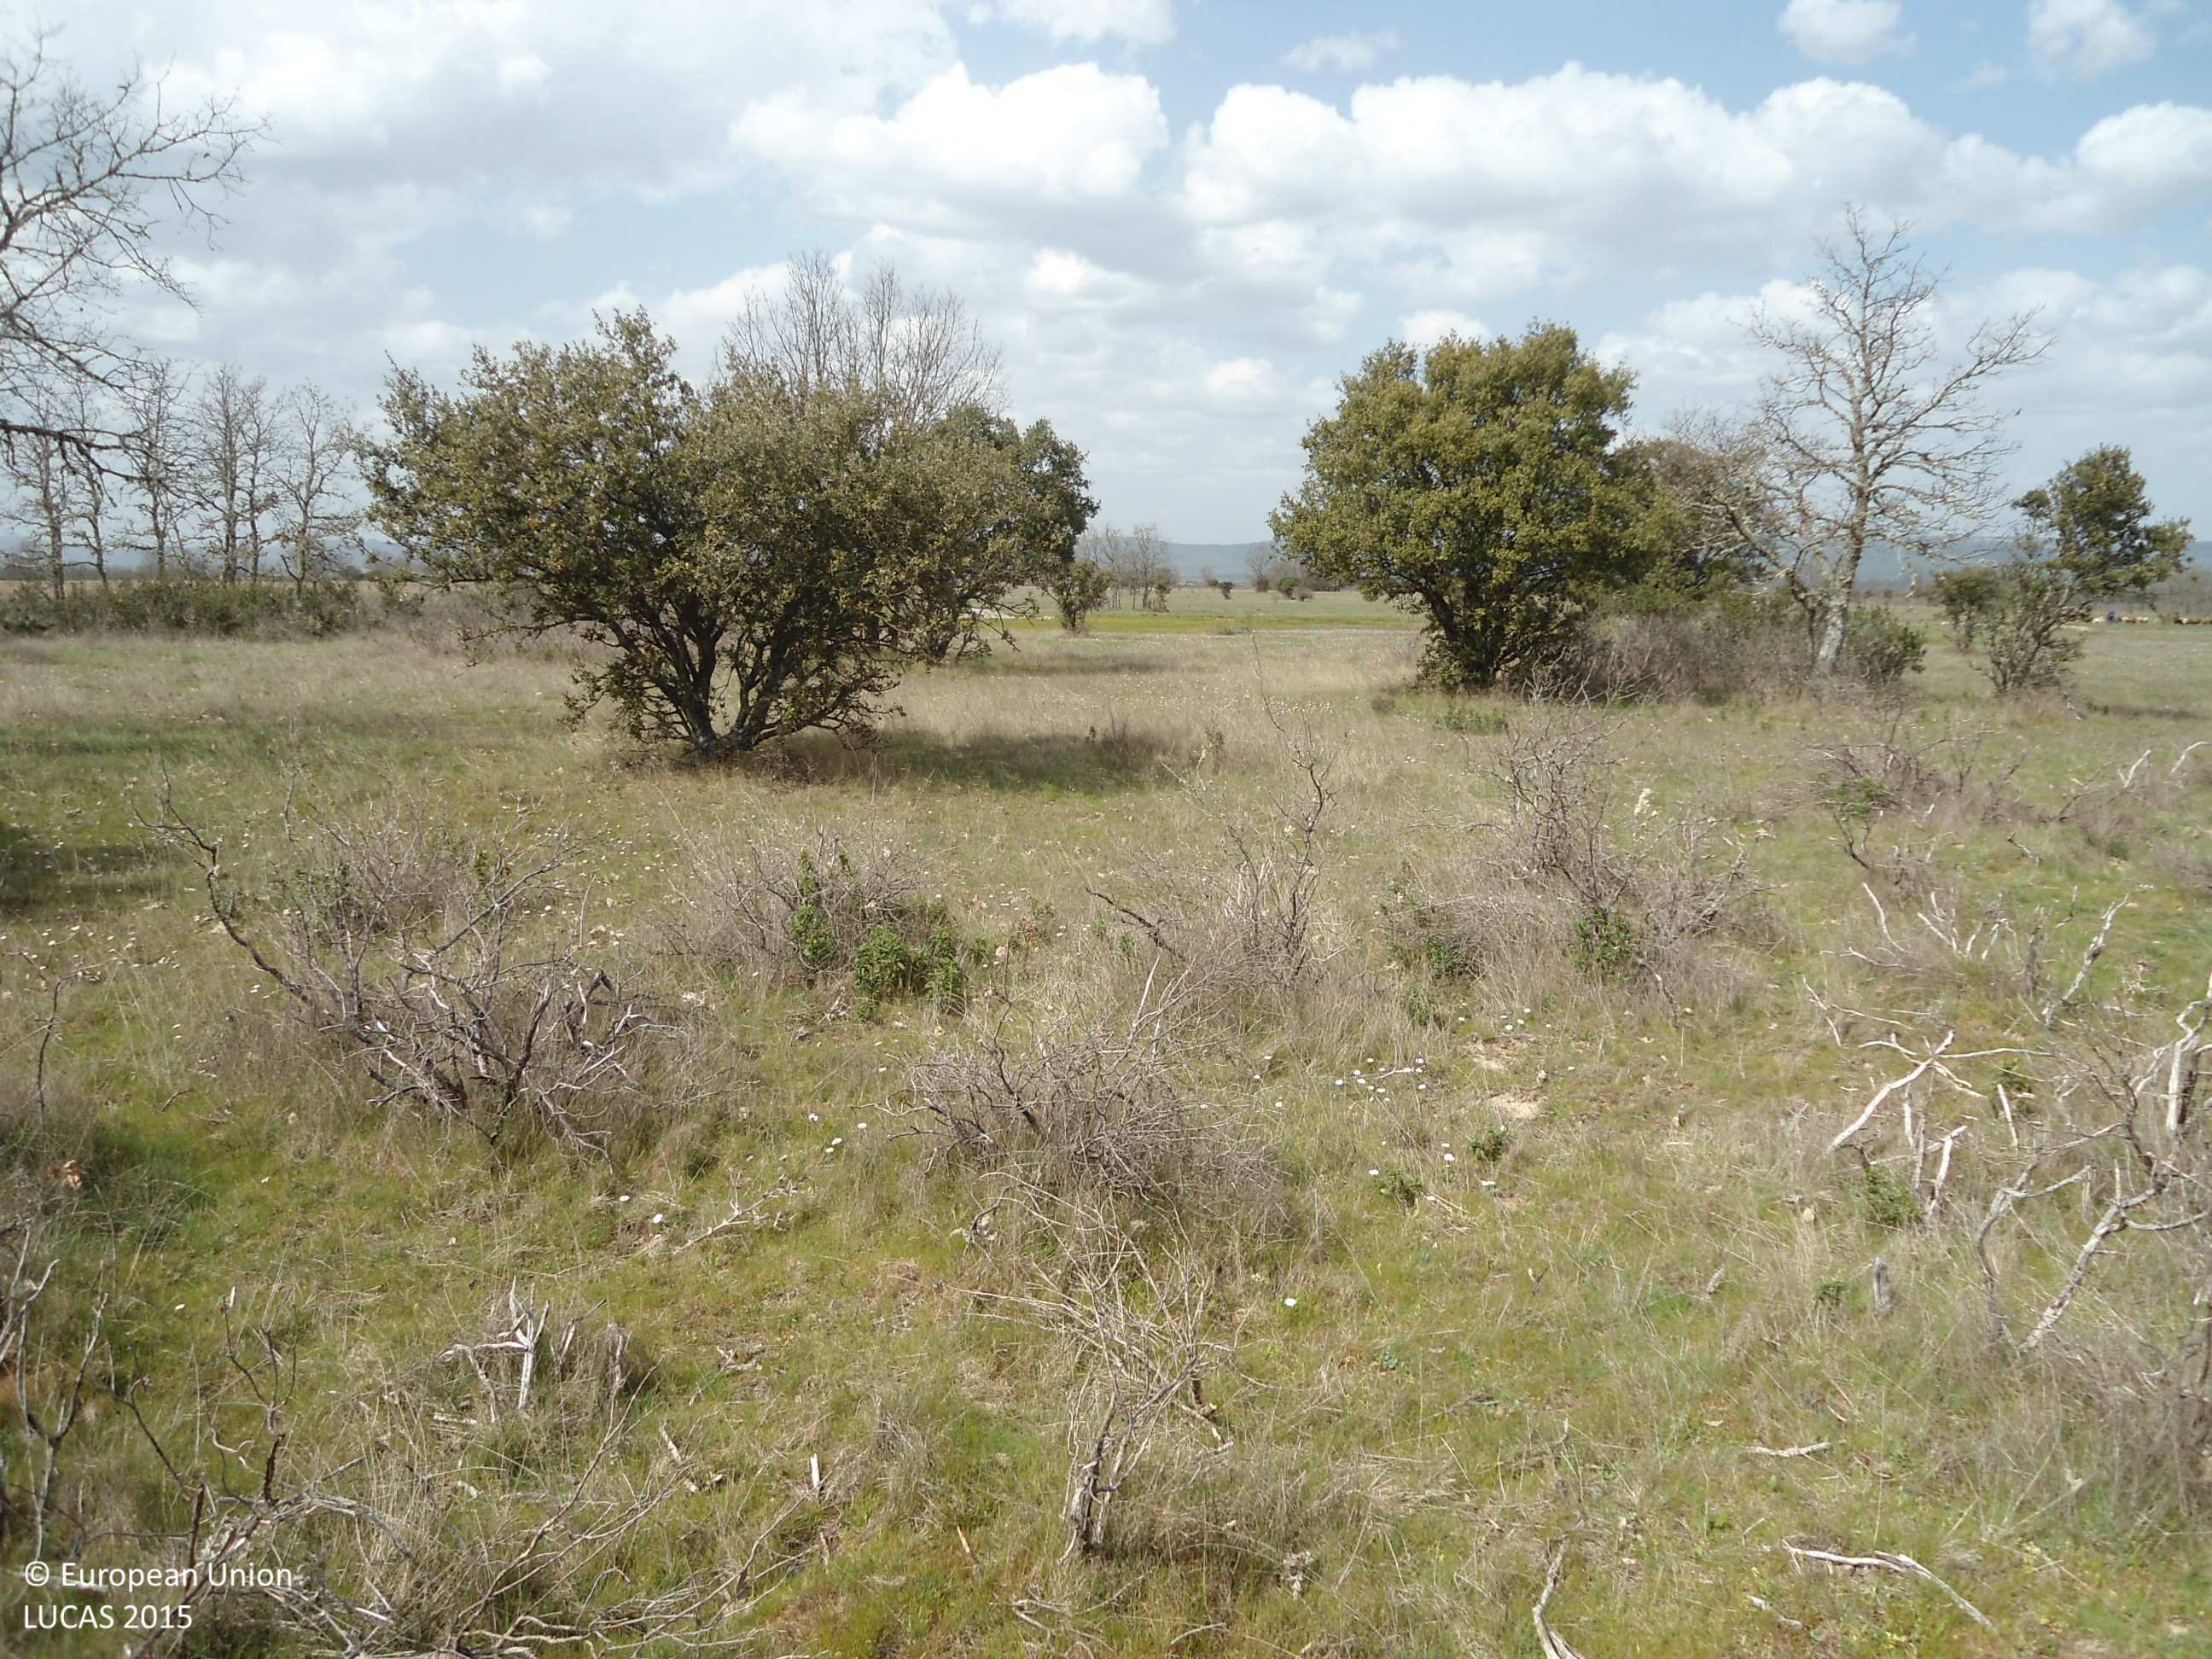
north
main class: Woodland
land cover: Broadleaved woodland
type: acidophilous oak and oak-birch forest
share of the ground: 25 - 50 %
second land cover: Grassland without tree/shrub cover
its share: 50 - 75 %
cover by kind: broadleaved forest trees 50 %, herbaceous plants 50 %
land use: Forestry
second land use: Agriculture (excluding fallow land and kitchen gardens)
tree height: < 5 m
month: April
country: ES
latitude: 41.7951
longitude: -6.3375
